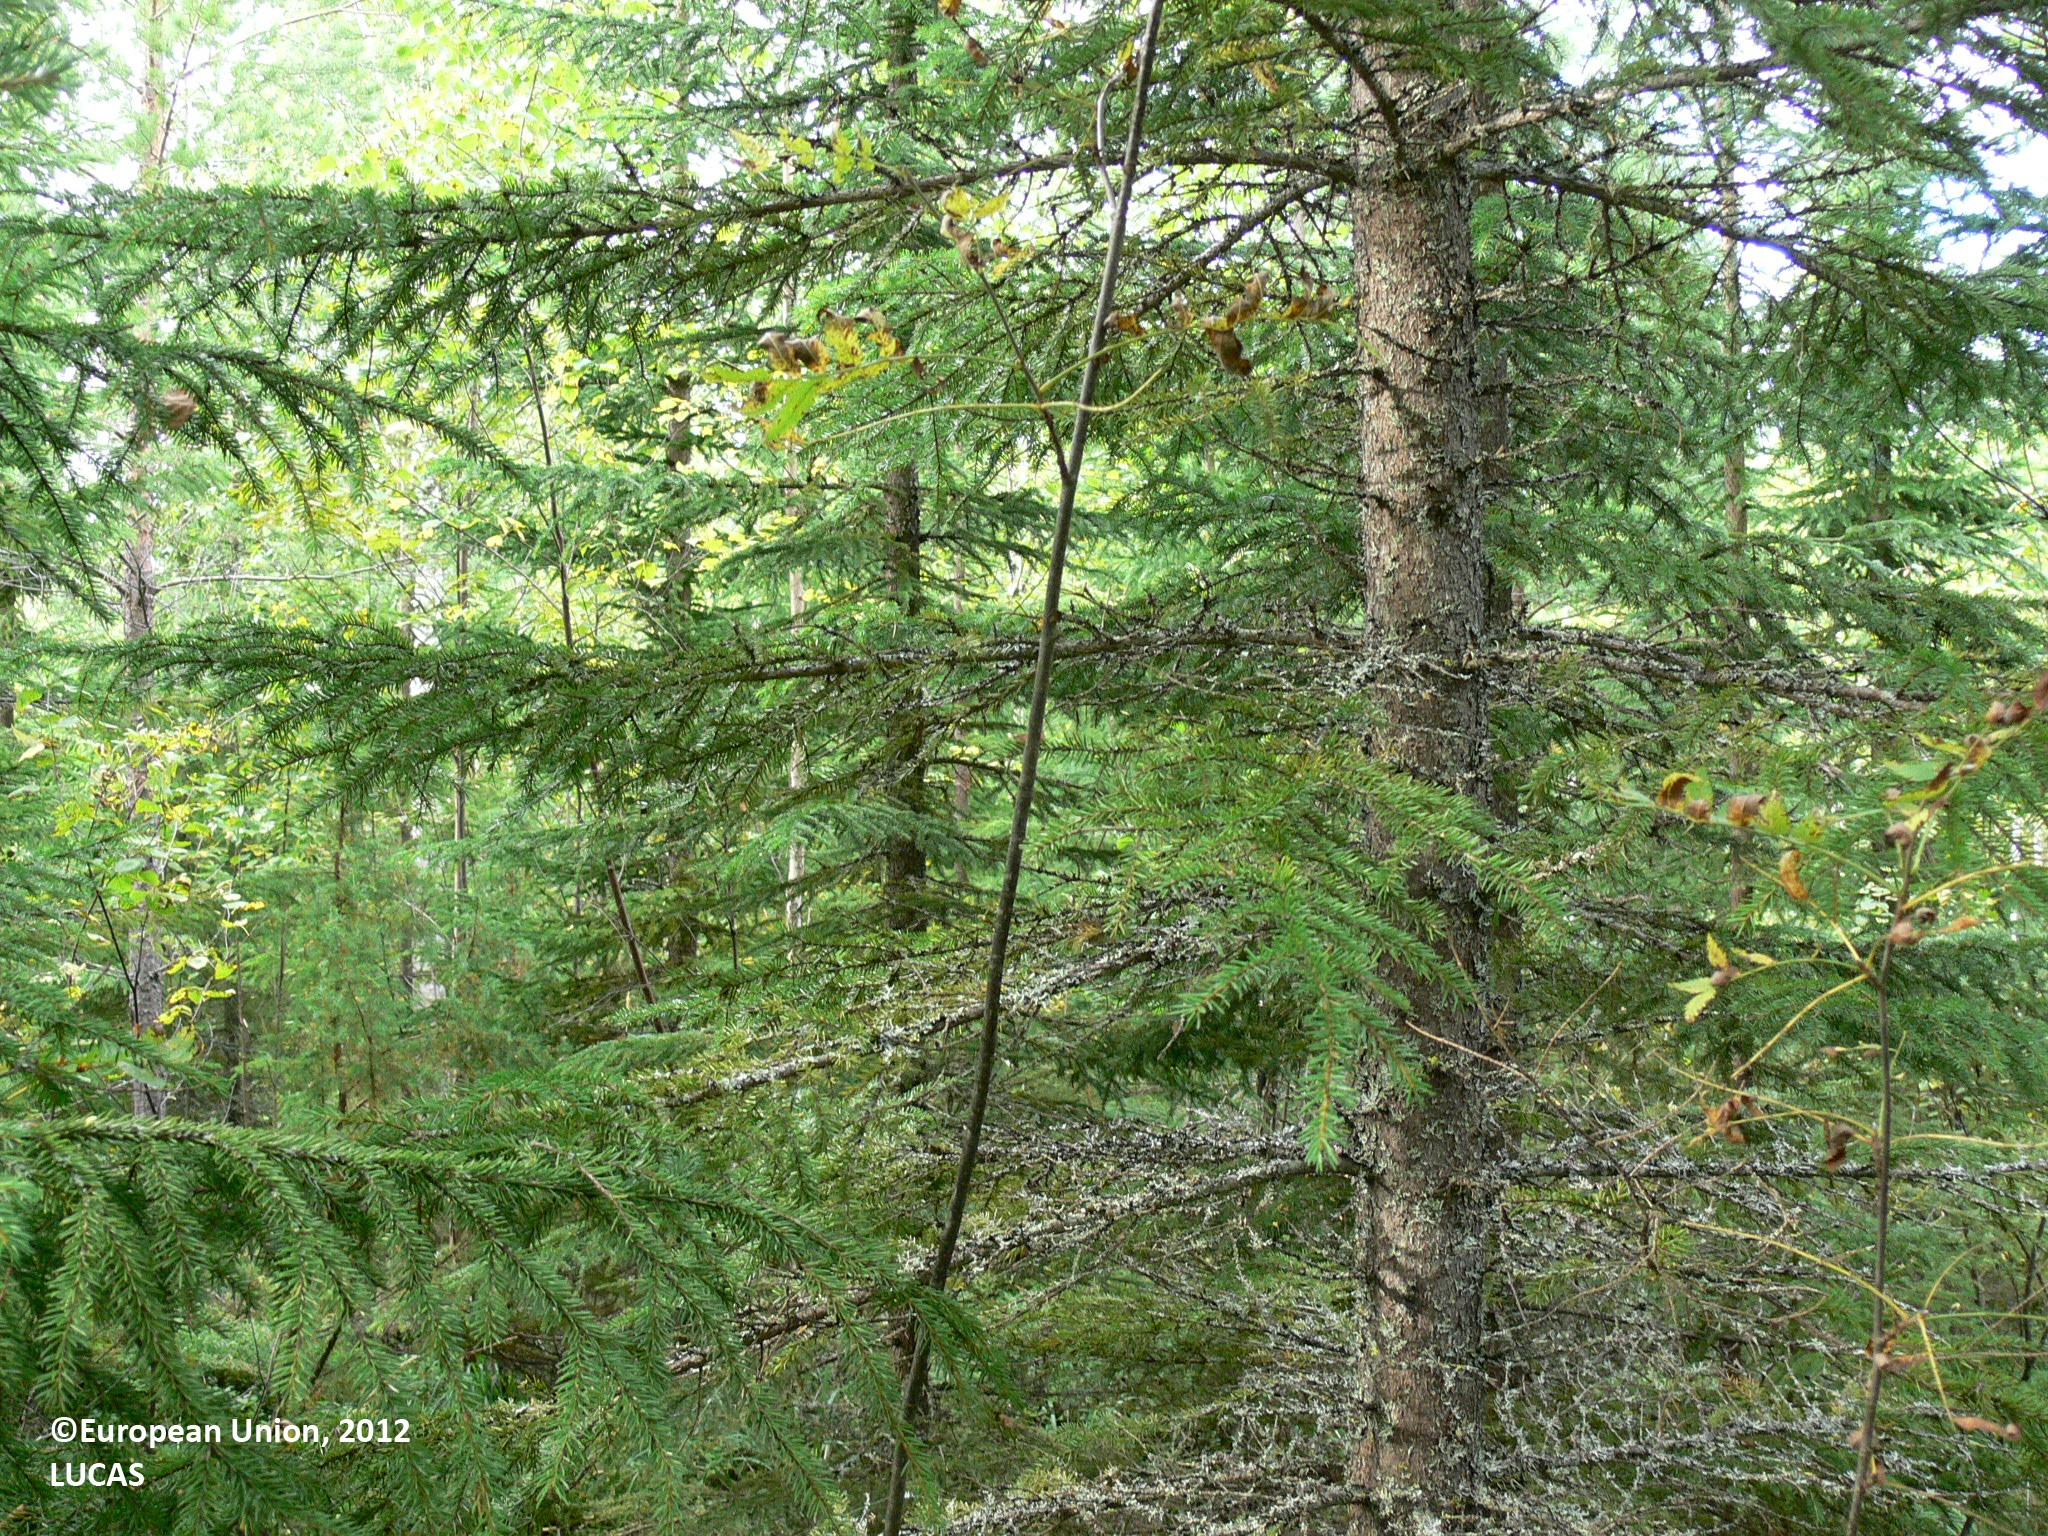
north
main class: Woodland
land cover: Spruce dominated mixed woodland
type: boreal forest
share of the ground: > 75 %
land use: Forestry
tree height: > 5 m
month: August
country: FI
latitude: 63.3512
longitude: 30.0981
